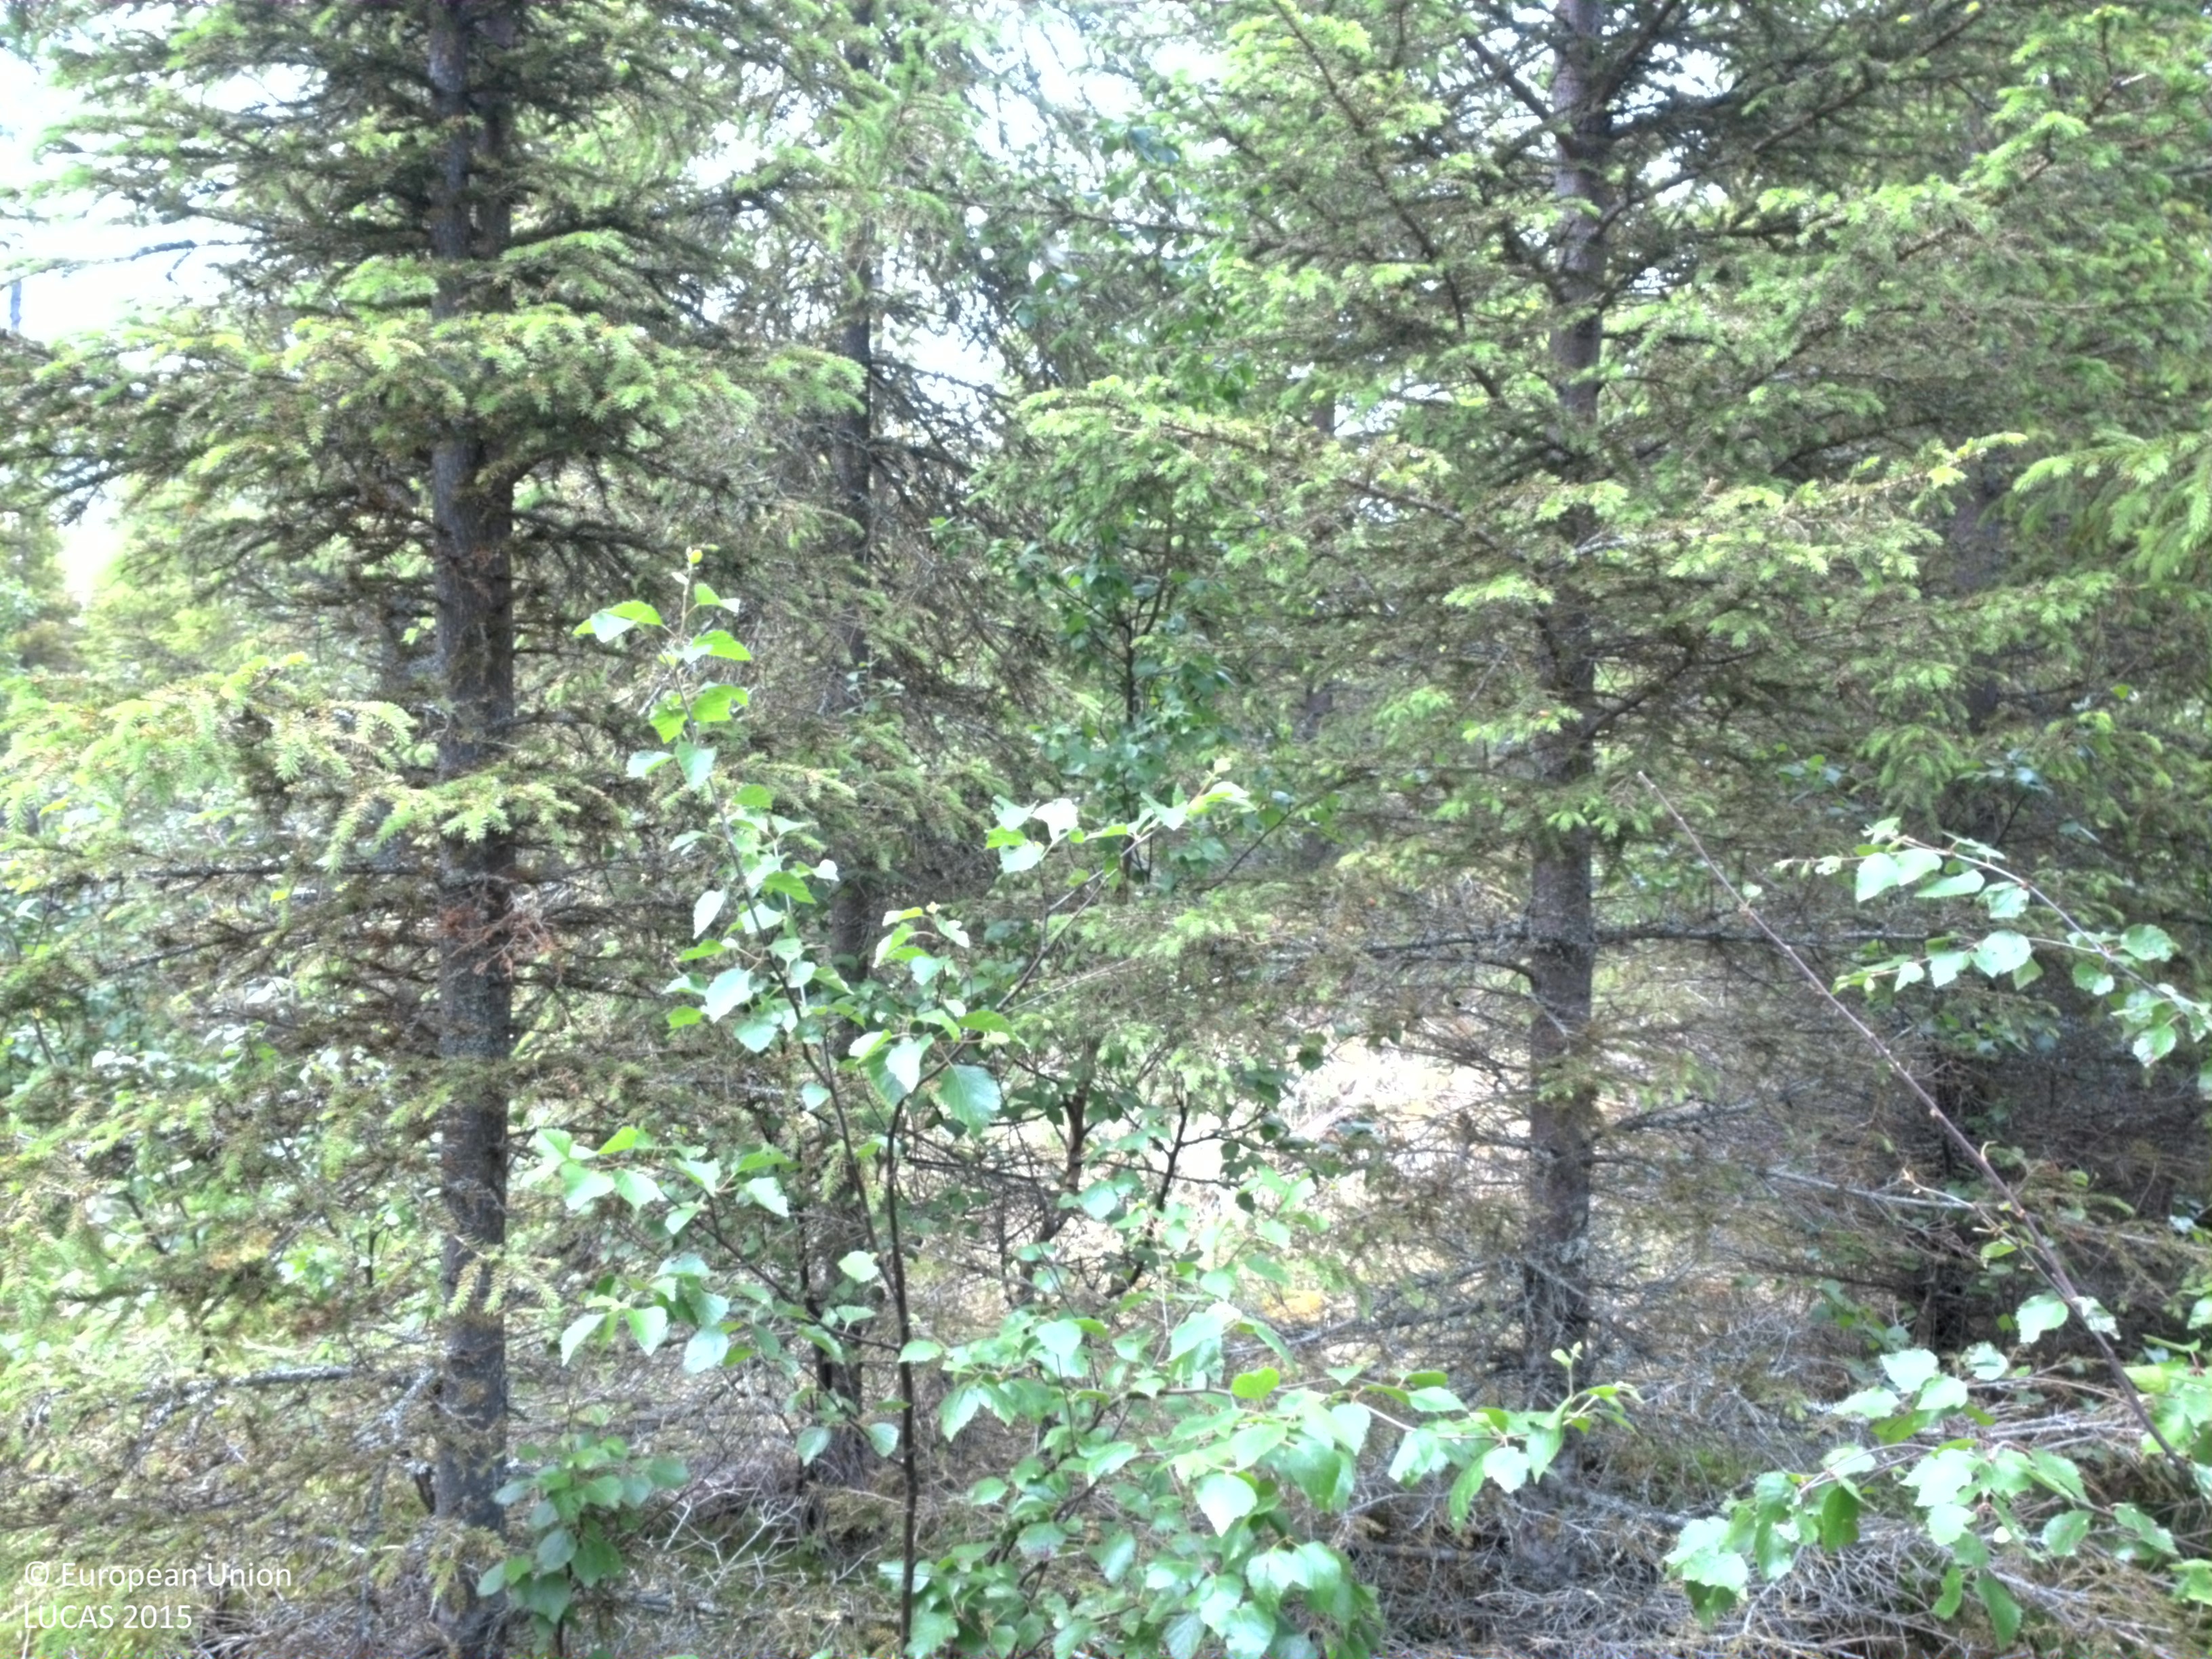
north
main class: Woodland
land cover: Spruce dominated mixed woodland
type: boreal forest
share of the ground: 50 - 75 %
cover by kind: coniferous forest trees 45 %, broadleaved forest trees 15 %, shrubs 15 %, herbaceous plants 15 %, lichens and mosses 10 %
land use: Forestry
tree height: > 5 m
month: July
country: SE
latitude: 64.4438
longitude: 18.1330
